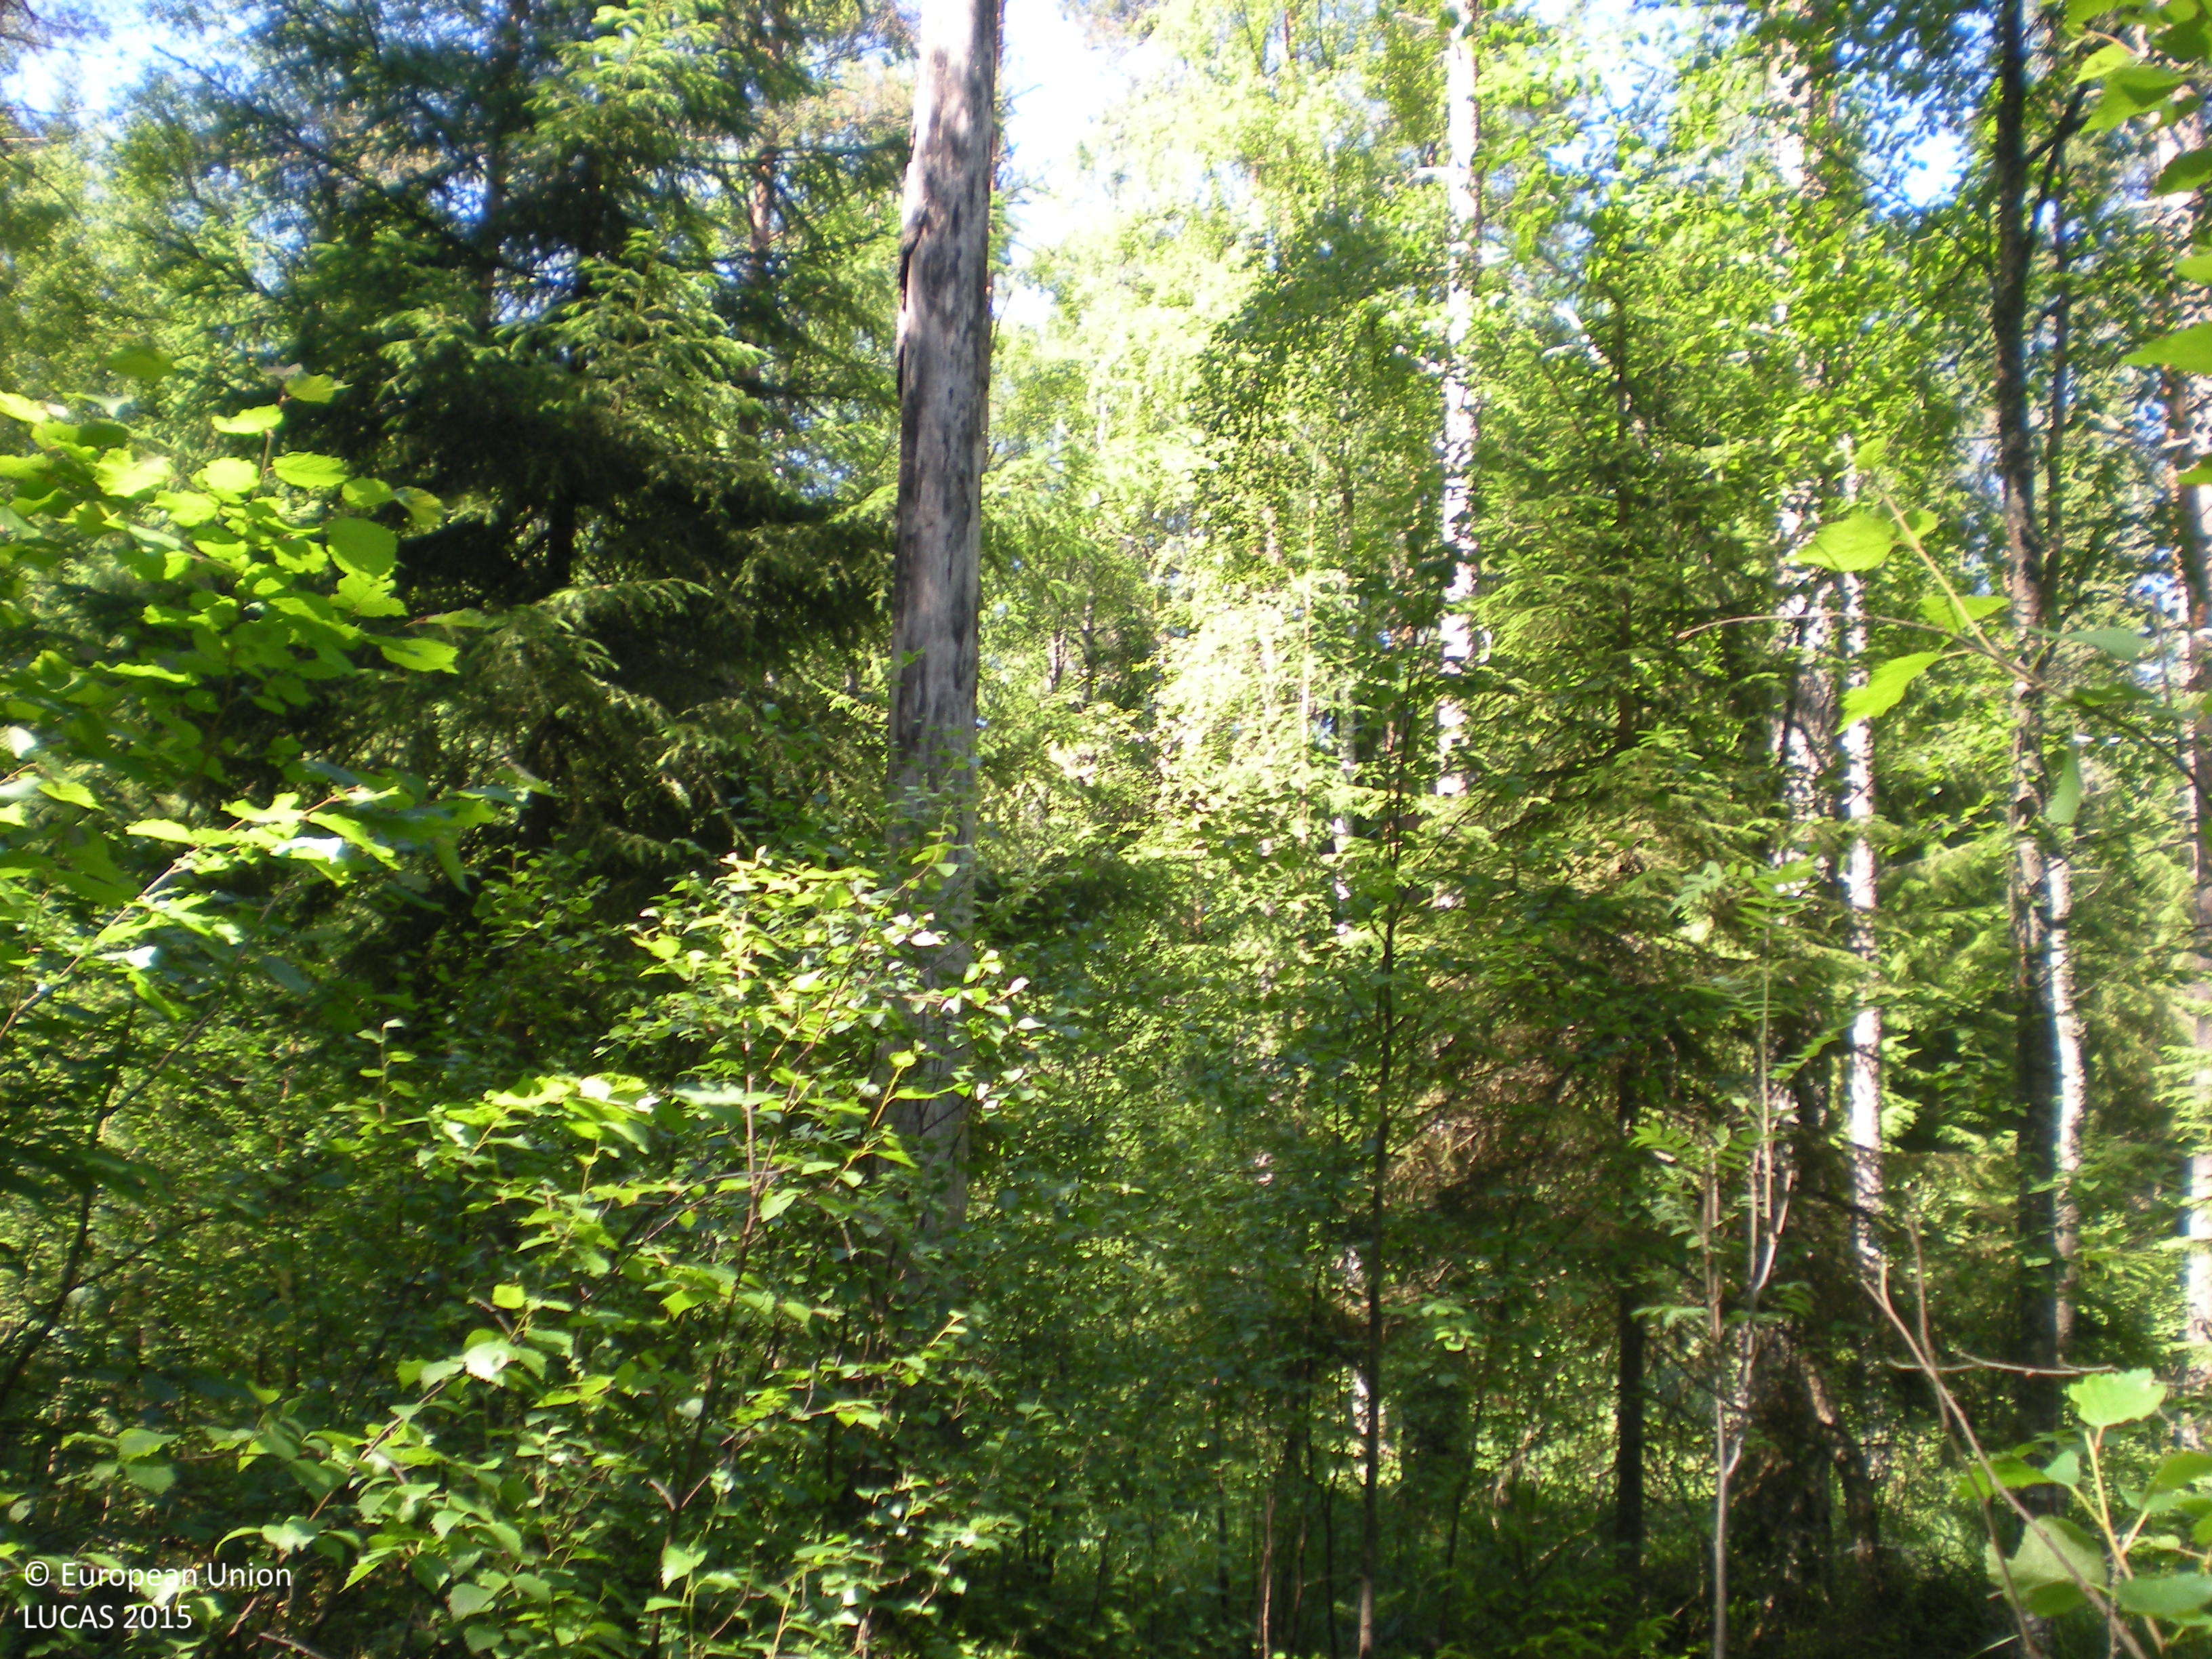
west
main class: Woodland
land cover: Other mixed woodland
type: boreal forest
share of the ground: 50 - 75 %
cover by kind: coniferous forest trees 60 %, broadleaved forest trees 20 %, herbaceous plants 15 %, lichens and mosses 5 %
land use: Forestry
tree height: > 5 m
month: July
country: SE
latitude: 60.4718
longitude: 17.7954
